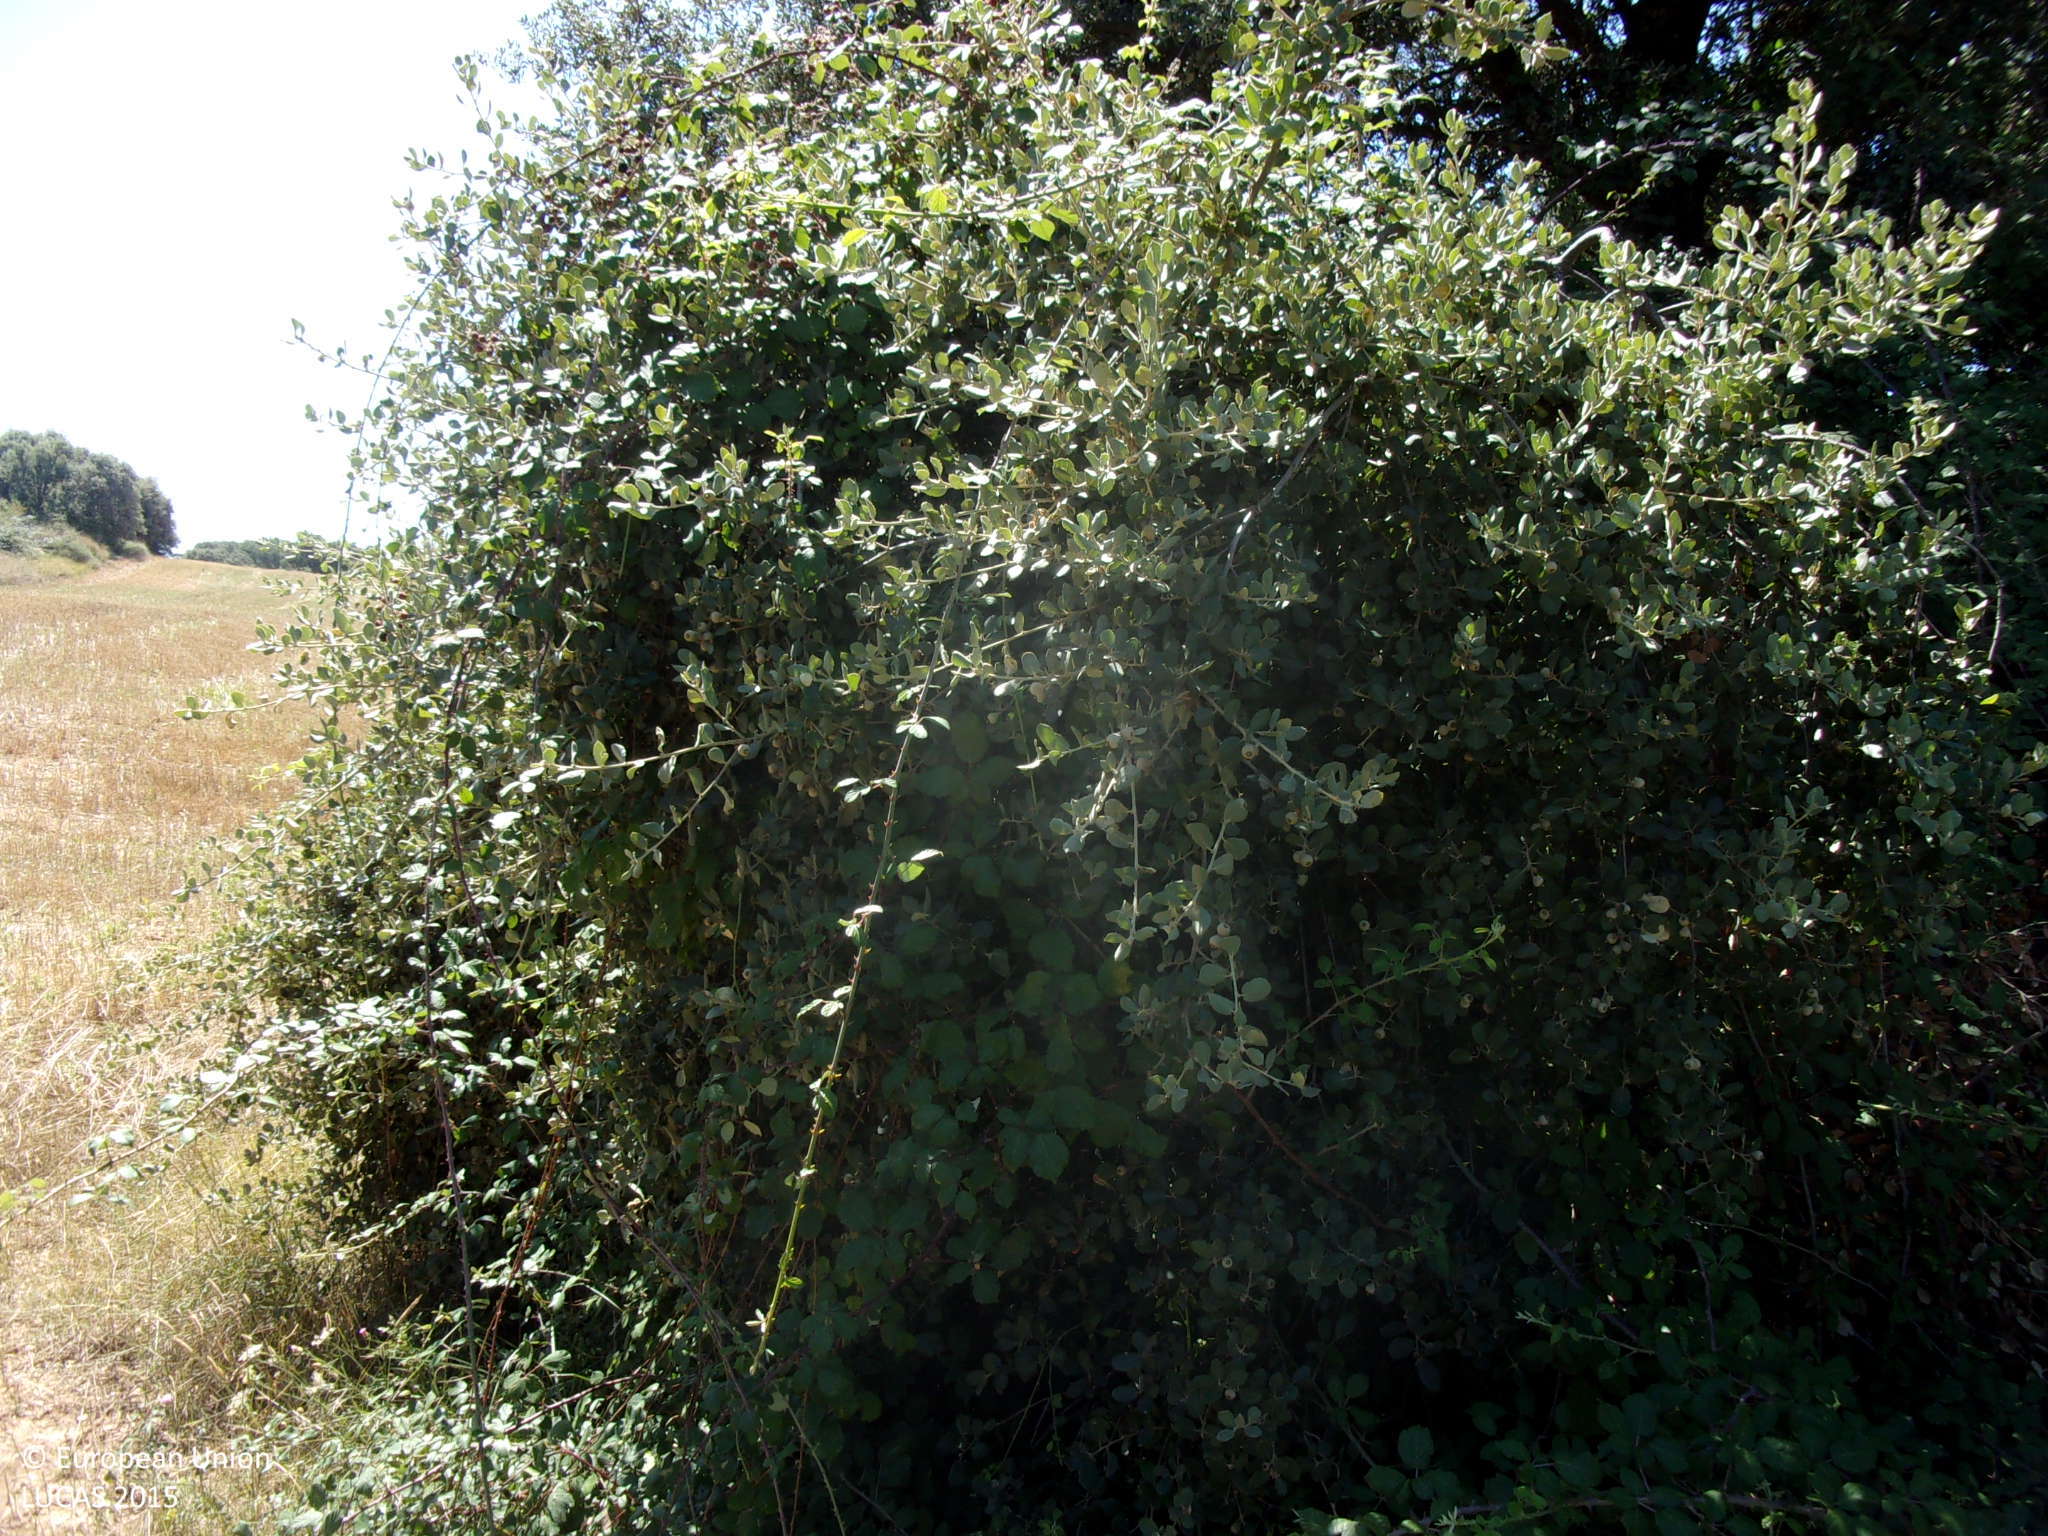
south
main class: Woodland
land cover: Broadleaved woodland
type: thermophilous deciduous forest
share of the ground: > 75 %
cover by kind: broadleaved forest trees 90 %, shrubs 10 %
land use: Forestry
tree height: < 5 m
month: August
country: ES
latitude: 42.3805
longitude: -1.1680
